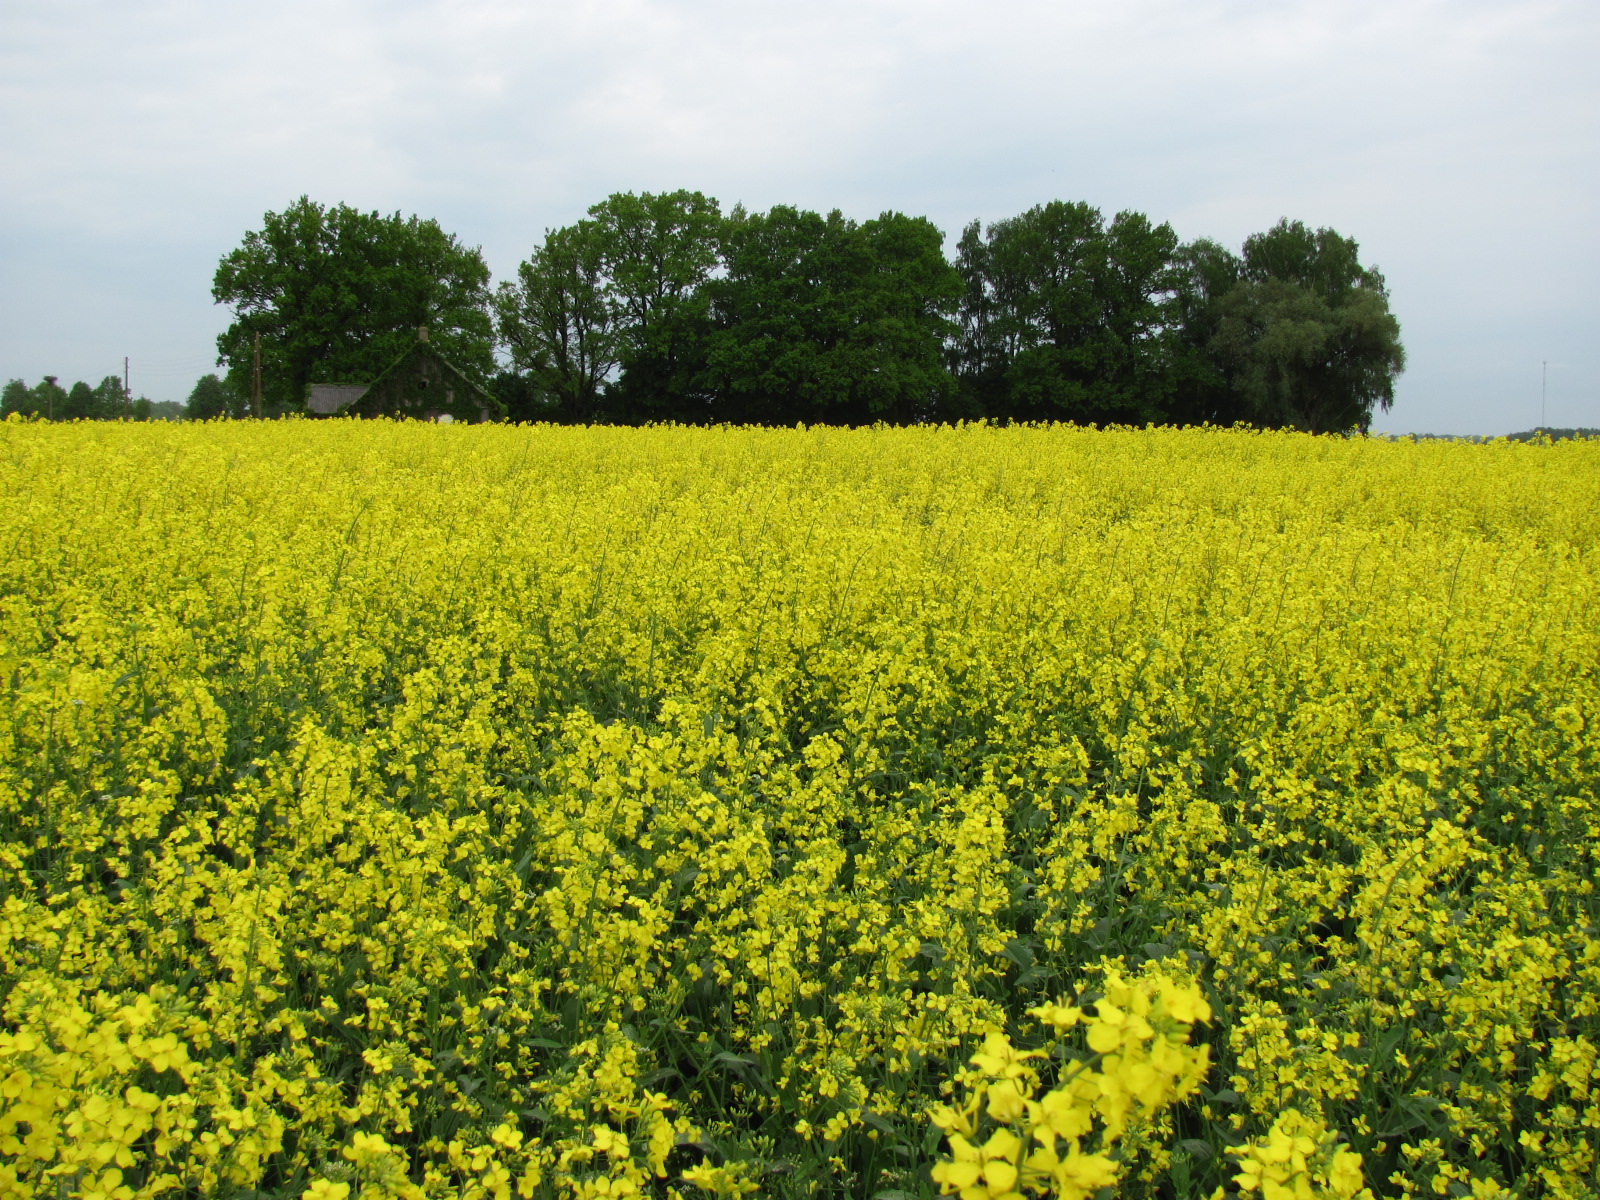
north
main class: Cropland
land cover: Rape and turnip rape
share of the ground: > 75 %
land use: Agriculture (excluding fallow land and kitchen gardens)
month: May
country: LV
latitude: 56.4792
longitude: 24.1325
